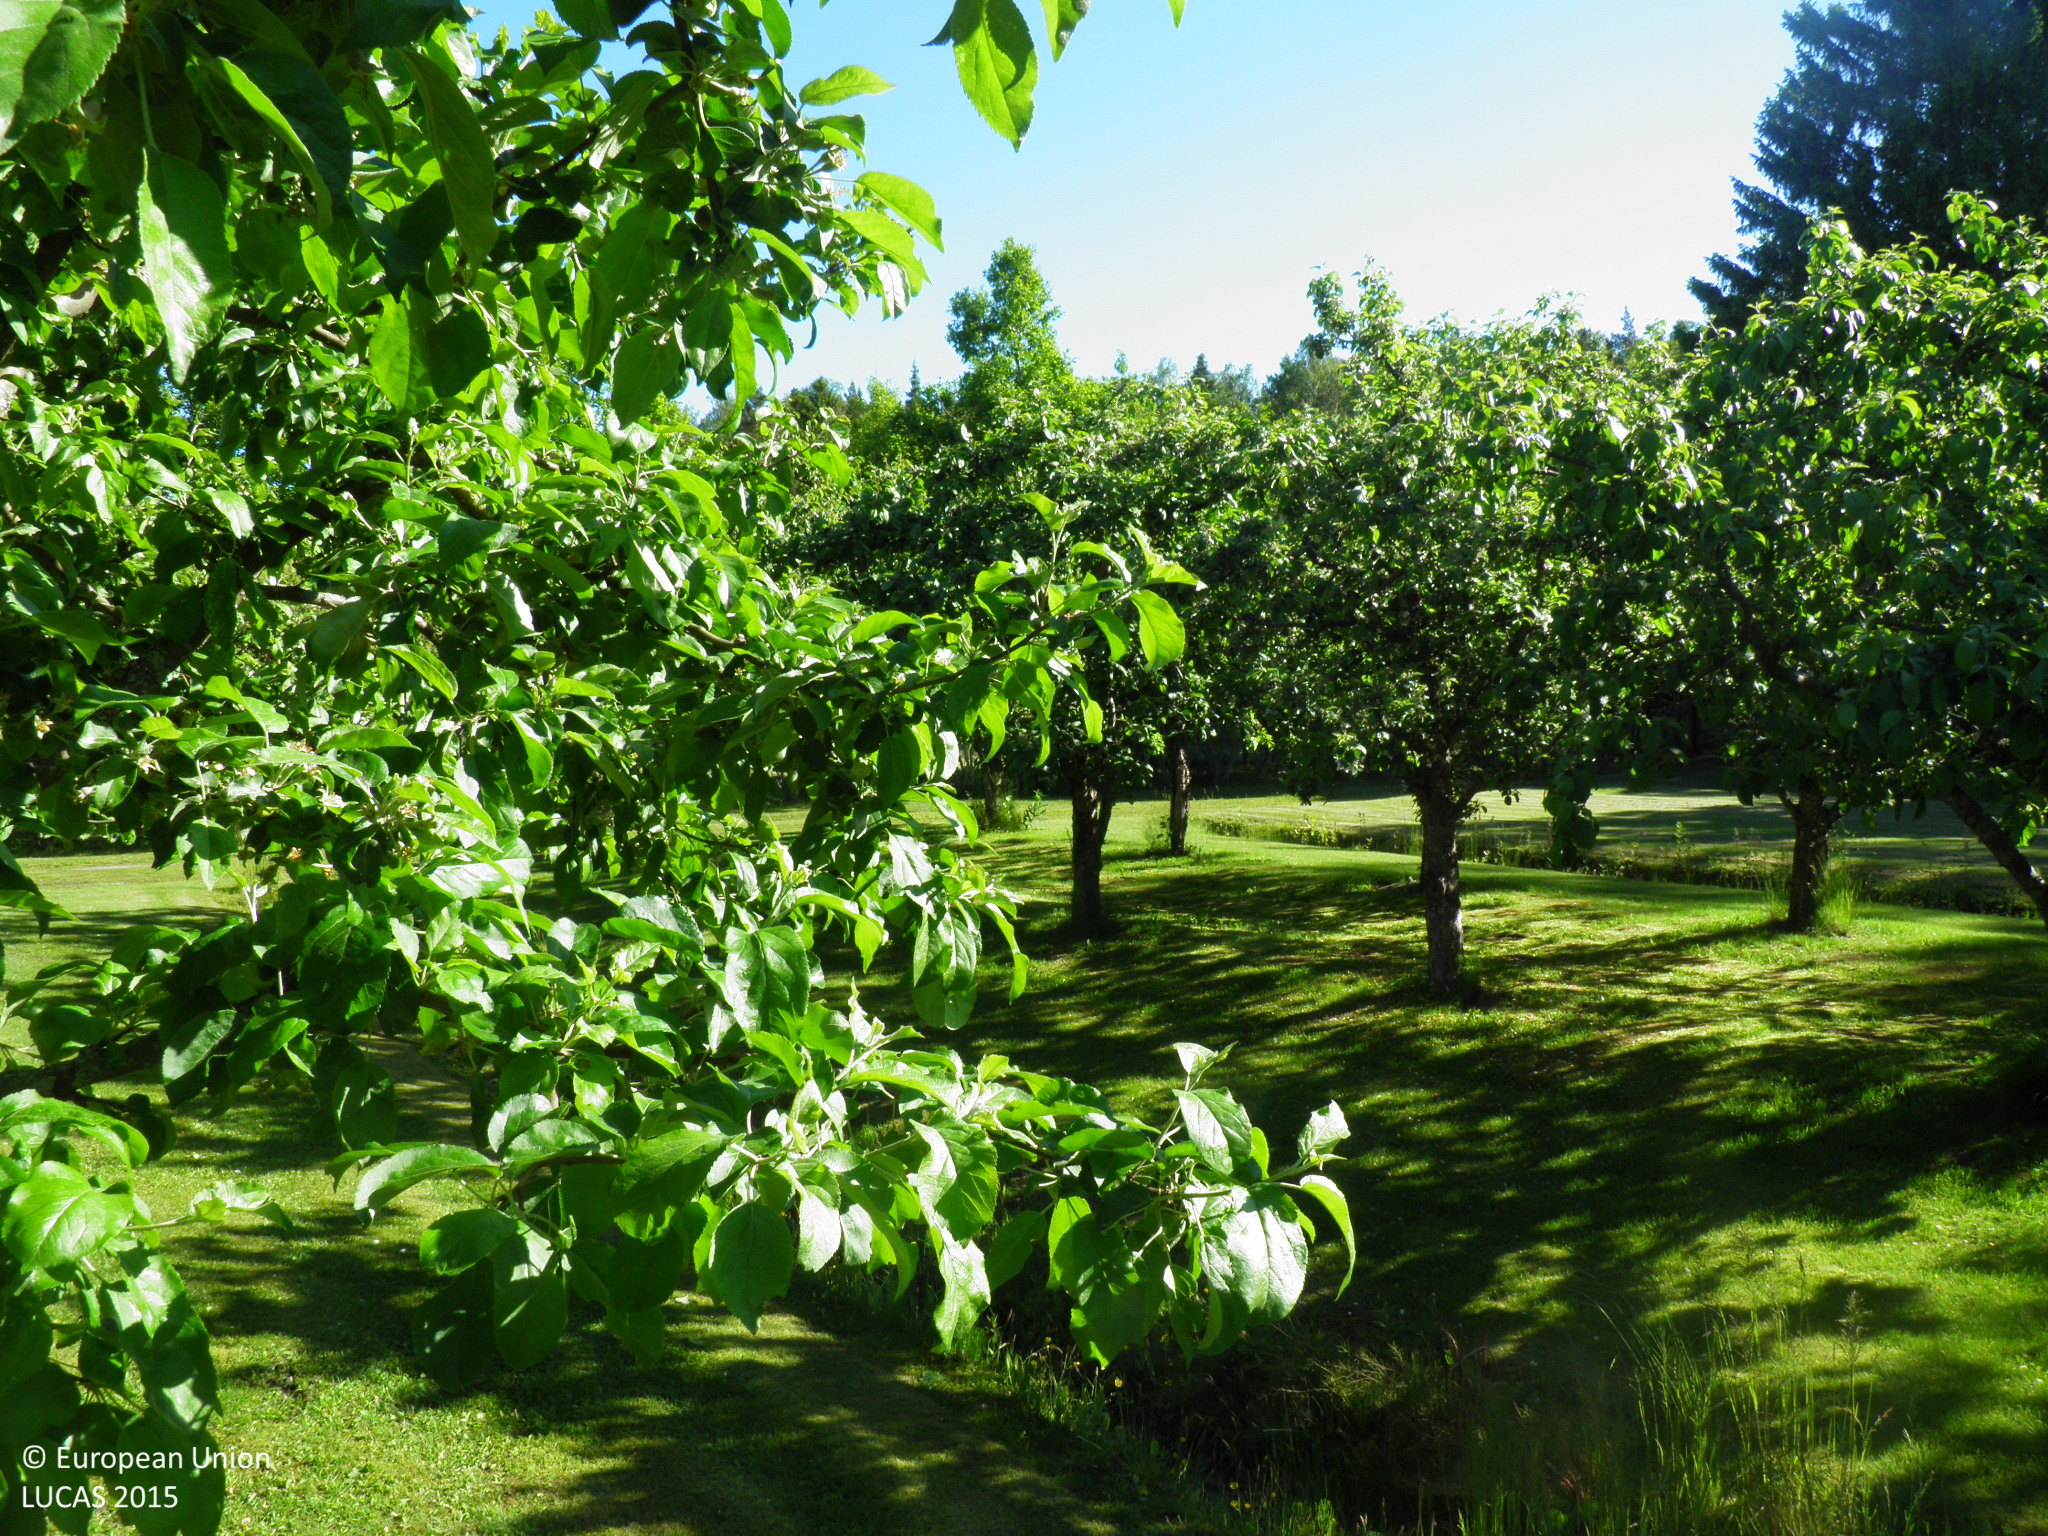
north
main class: Cropland
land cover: Apple fruit
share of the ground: 50 - 75 %
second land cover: Grassland without tree/shrub cover
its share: > 75 %
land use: Kitchen garden
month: June
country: FI
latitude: 60.3826
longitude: 22.5705
